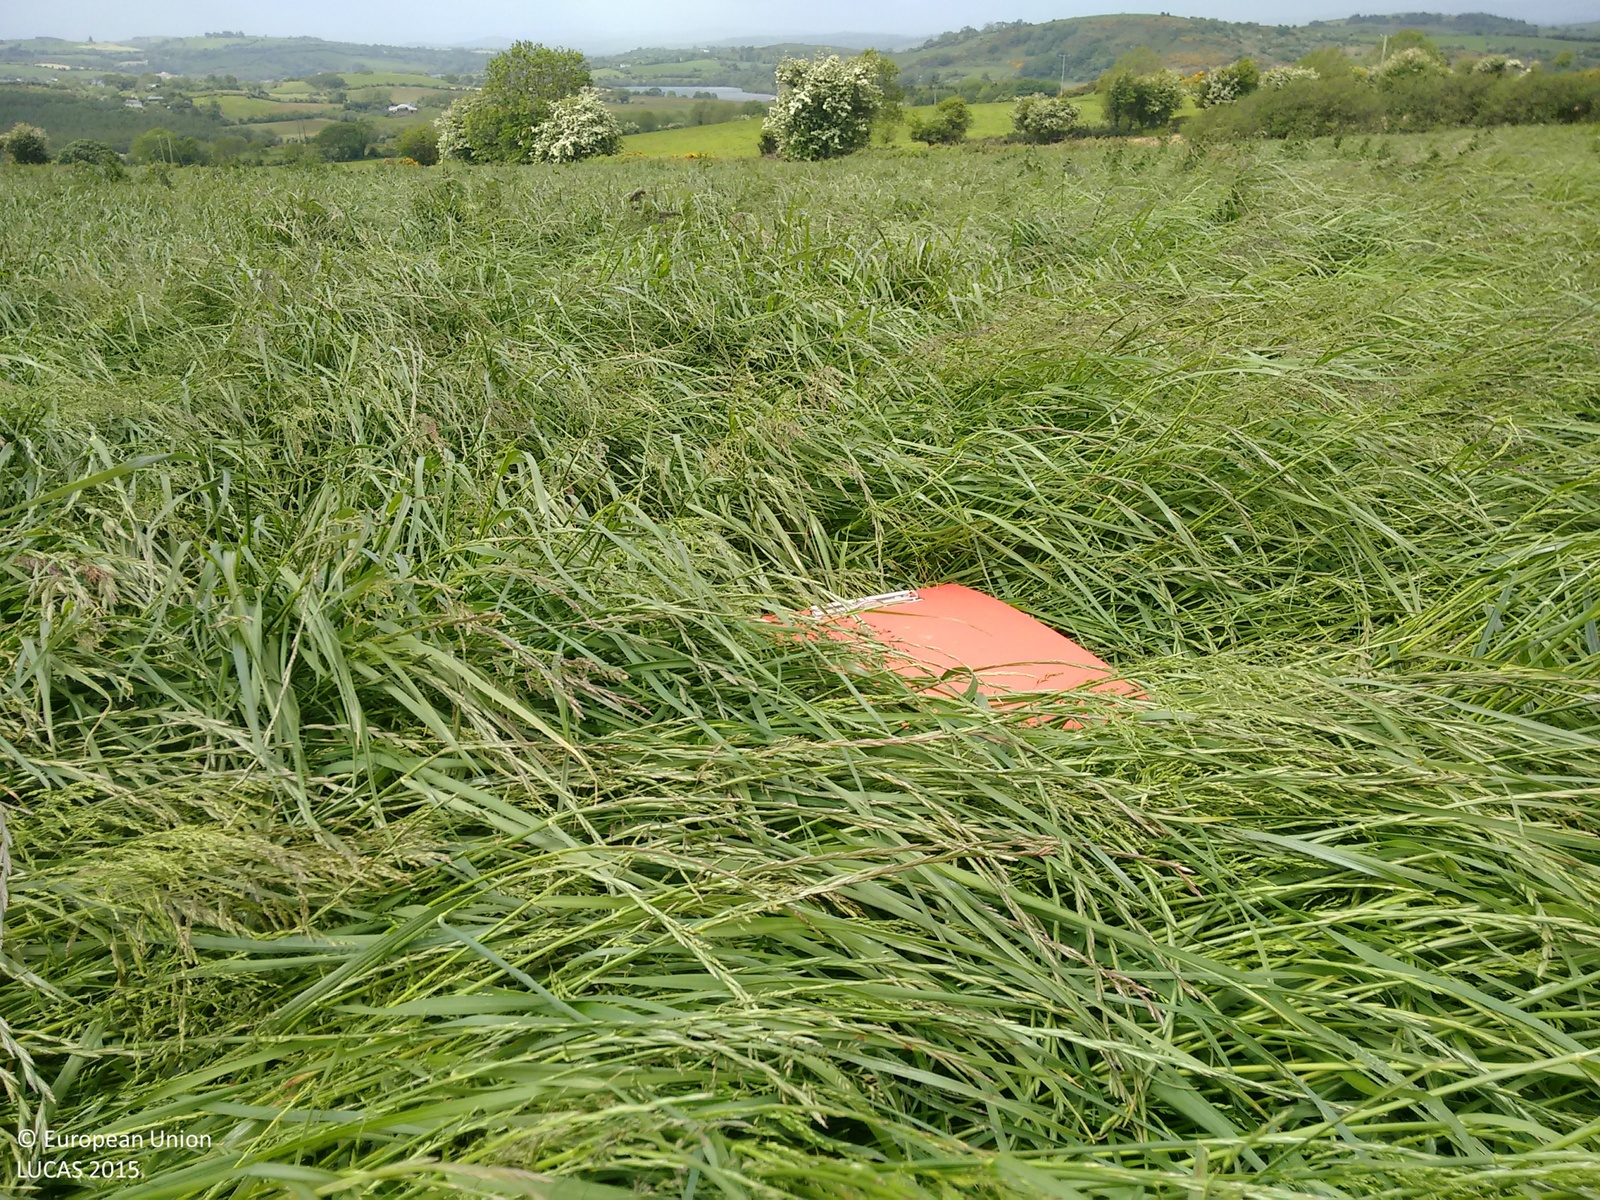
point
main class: Grassland
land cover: Grassland without tree/shrub cover
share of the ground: > 75 %
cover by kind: herbaceous plants 100 %
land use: Agriculture (excluding fallow land and kitchen gardens)
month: June
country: IE
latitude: 51.8782
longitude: -8.8745
